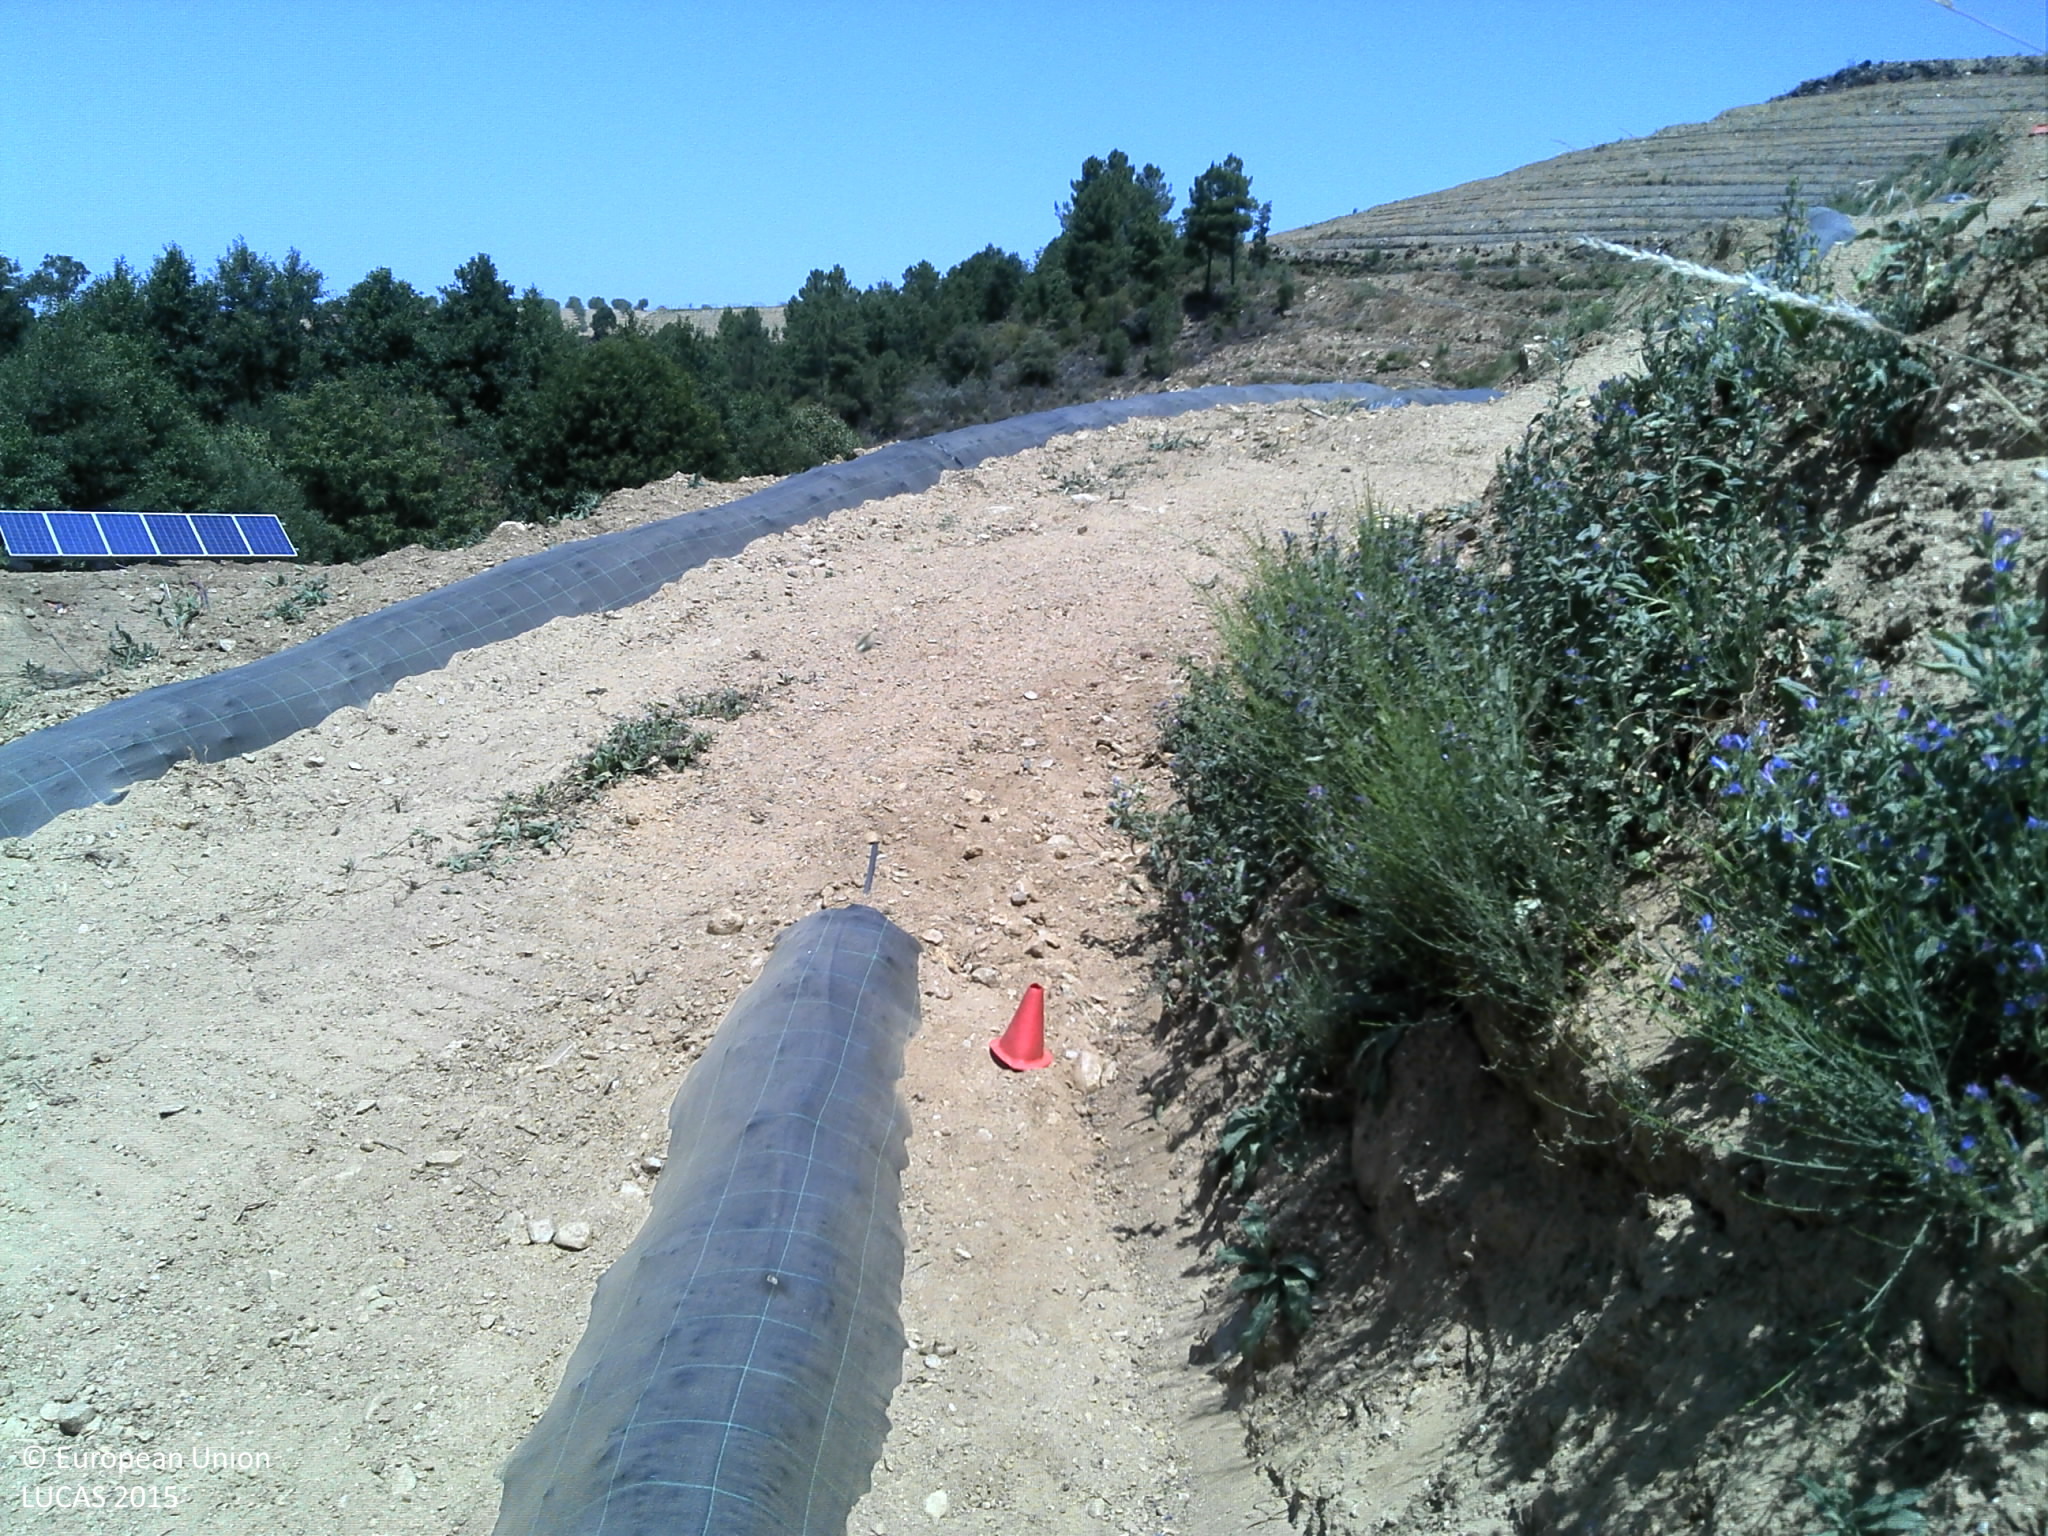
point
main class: Grassland
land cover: Spontaneously vegetated surfaces
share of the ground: < 10 %
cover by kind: unconsolidated bare surface 90 %, herbaceous plants 10 %
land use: Fallow land
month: July
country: PT
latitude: 41.0592
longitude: -7.4073
